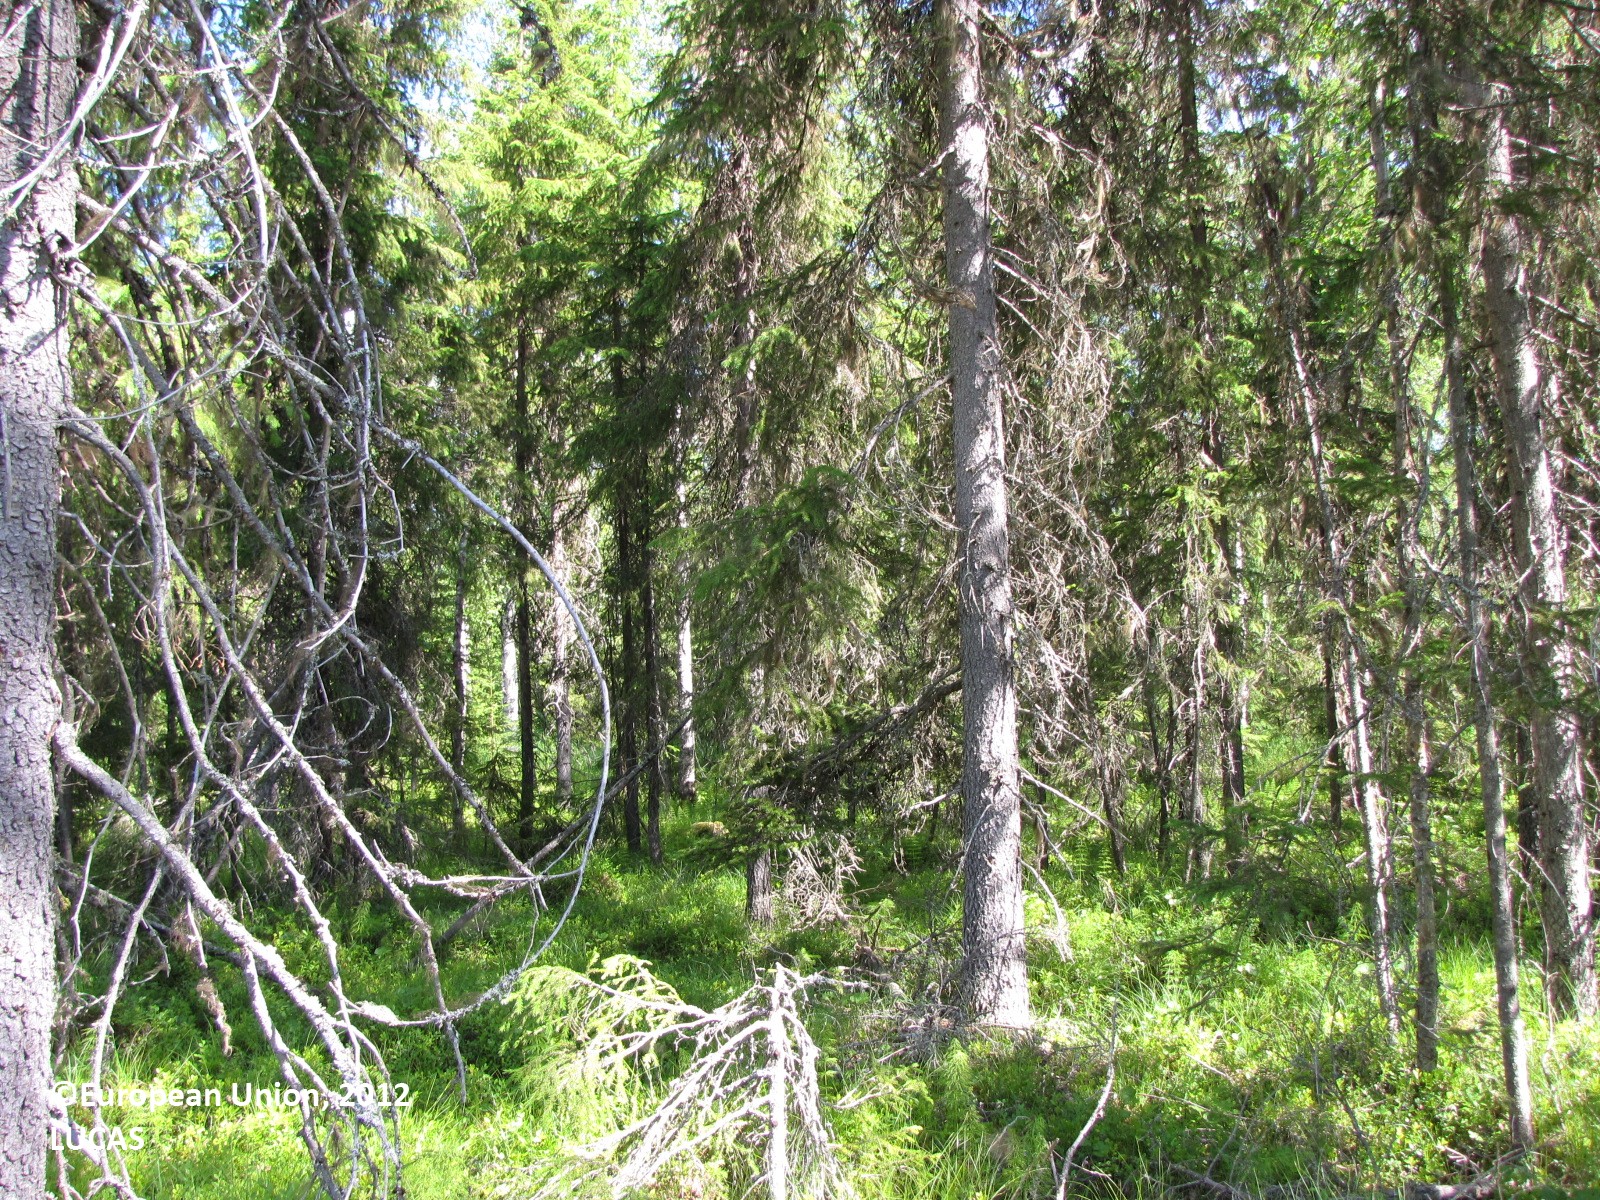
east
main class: Woodland
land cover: Spruce dominated mixed woodland
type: boreal forest
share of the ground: 25 - 50 %
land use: Forestry
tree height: > 5 m
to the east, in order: Spruce dominated mixed woodland; Ditches and canals; Spruce dominated mixed woodland; Electric lines; Spruce dominated mixed woodland; Pine dominated coniferous woodland; Spruce dominated mixed woodland
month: July
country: FI
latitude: 66.2435
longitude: 25.2561
